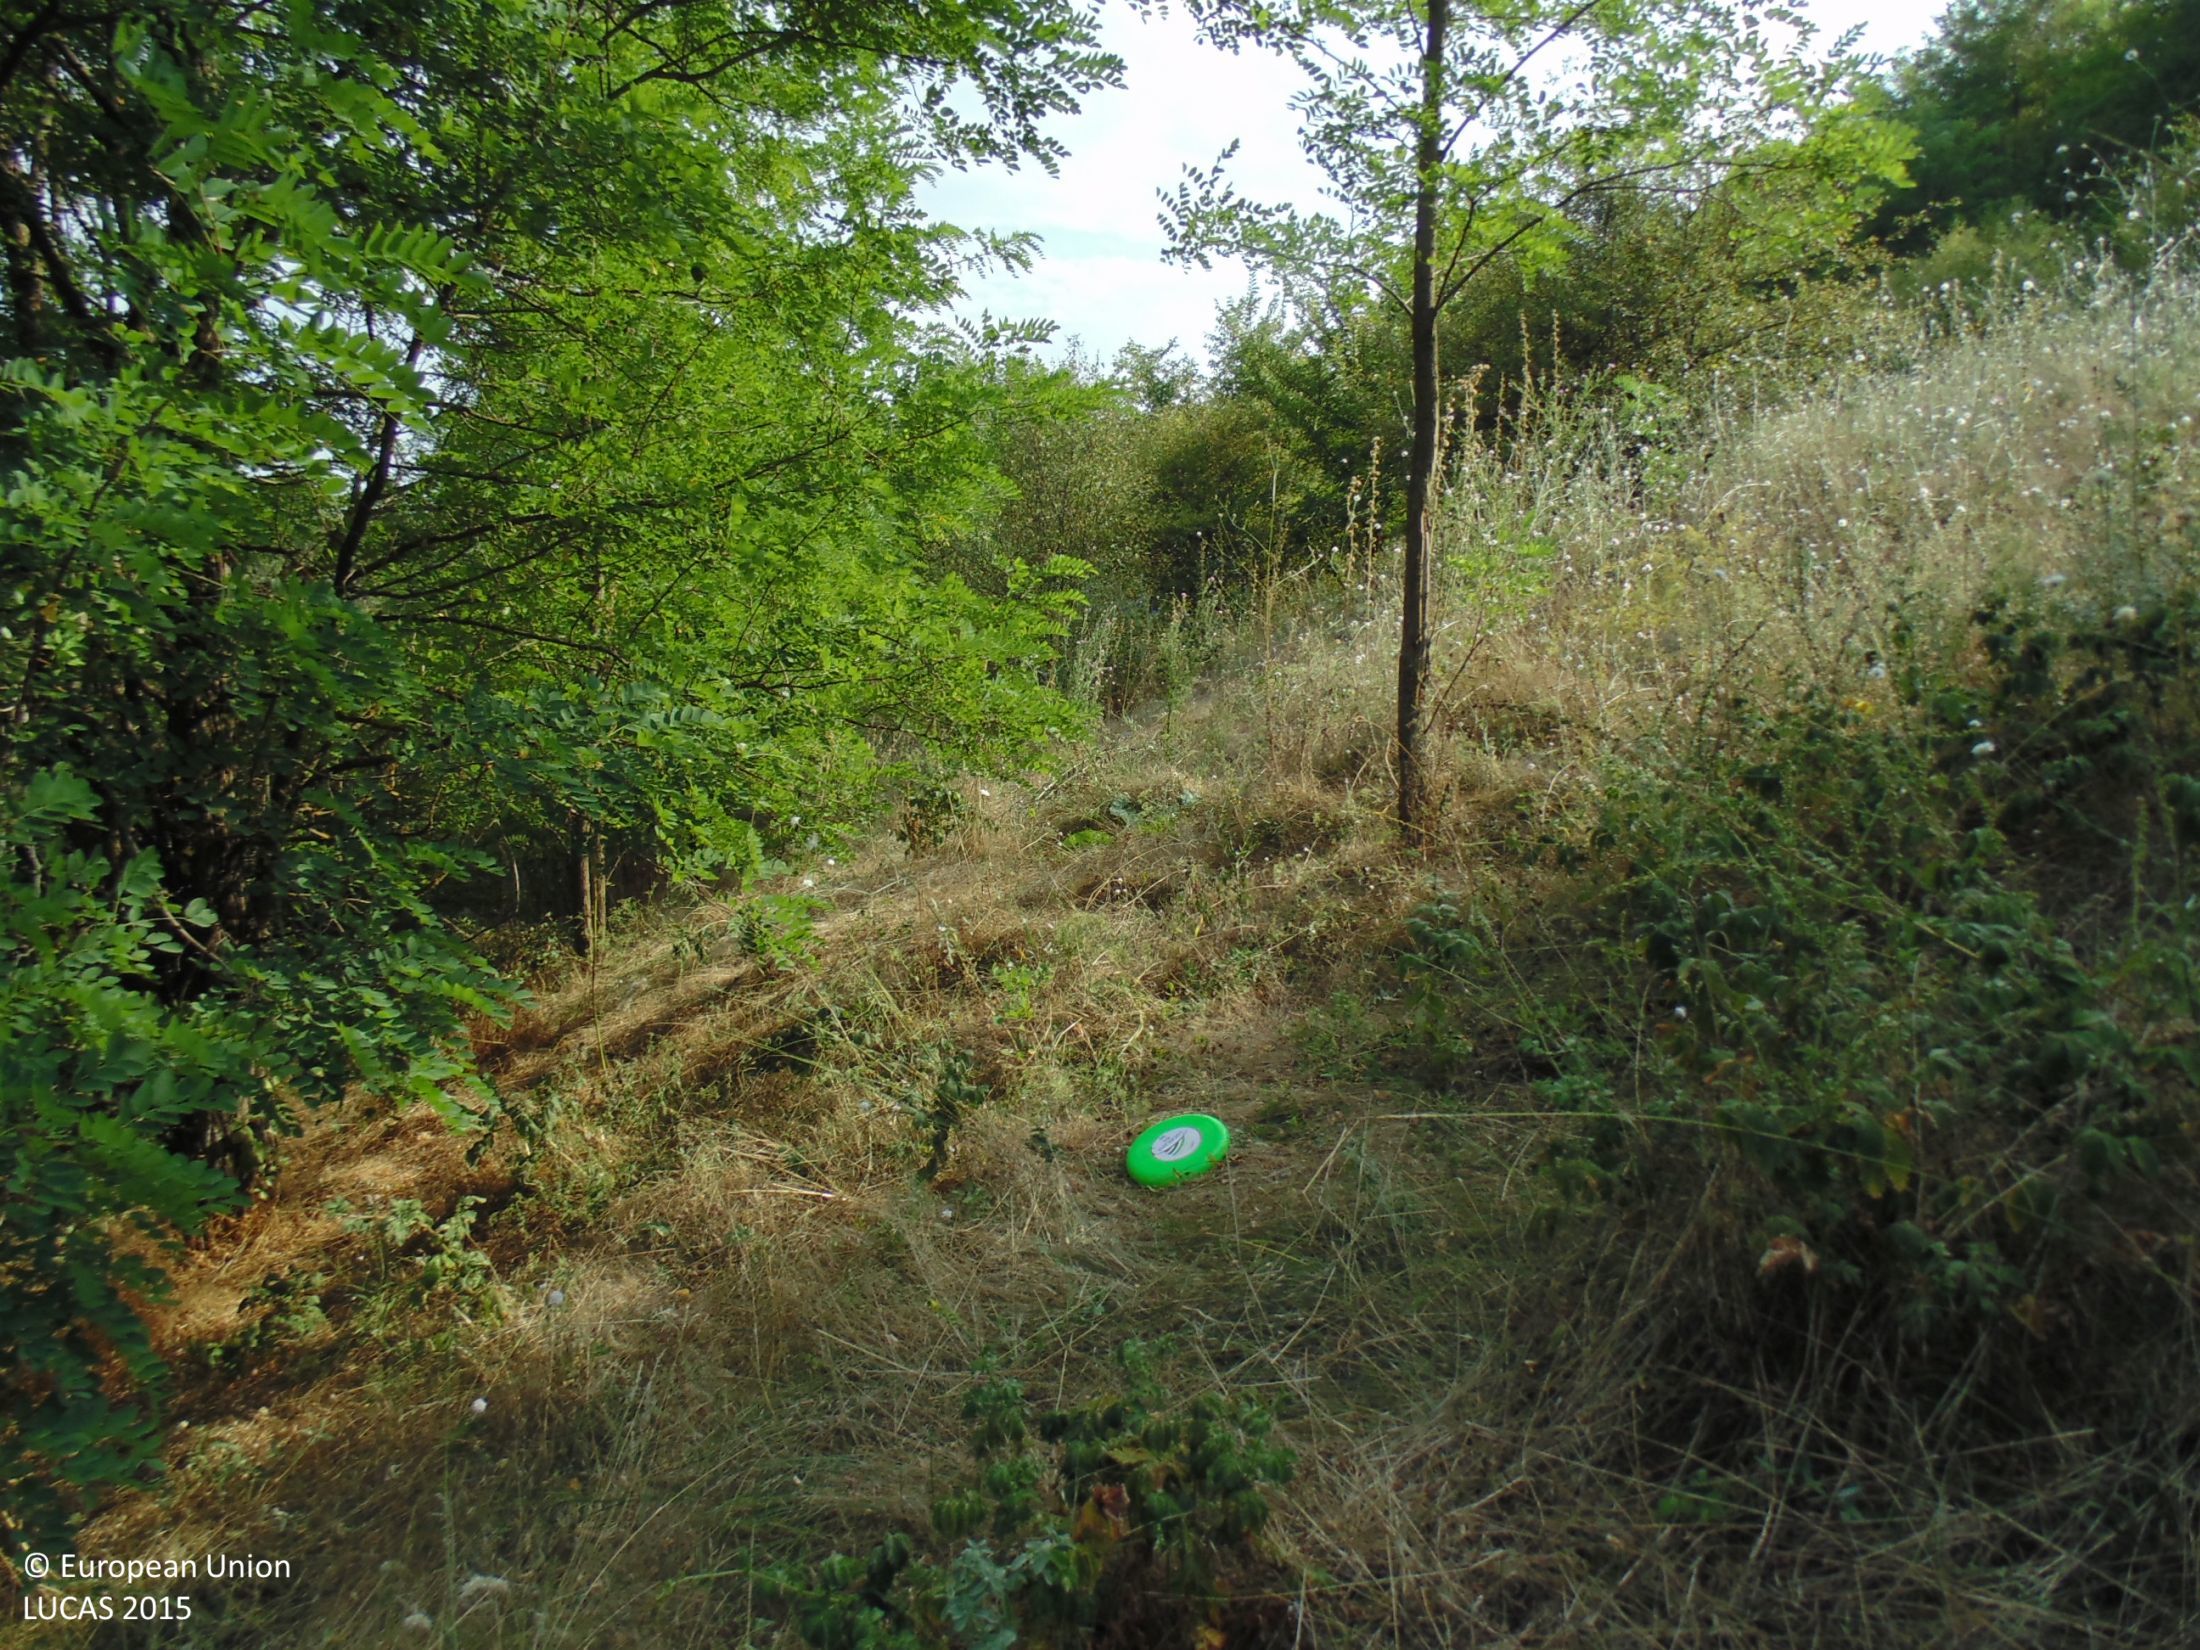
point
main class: Woodland
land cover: Broadleaved woodland
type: mesophytic deciduous forest
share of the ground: 50 - 75 %
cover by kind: broadleaved forest trees 70 %, shrubs 15 %, herbaceous plants 15 %
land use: Semi-natural and natural areas not in use
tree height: > 5 m
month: August
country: BG
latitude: 43.9392
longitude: 27.6956
